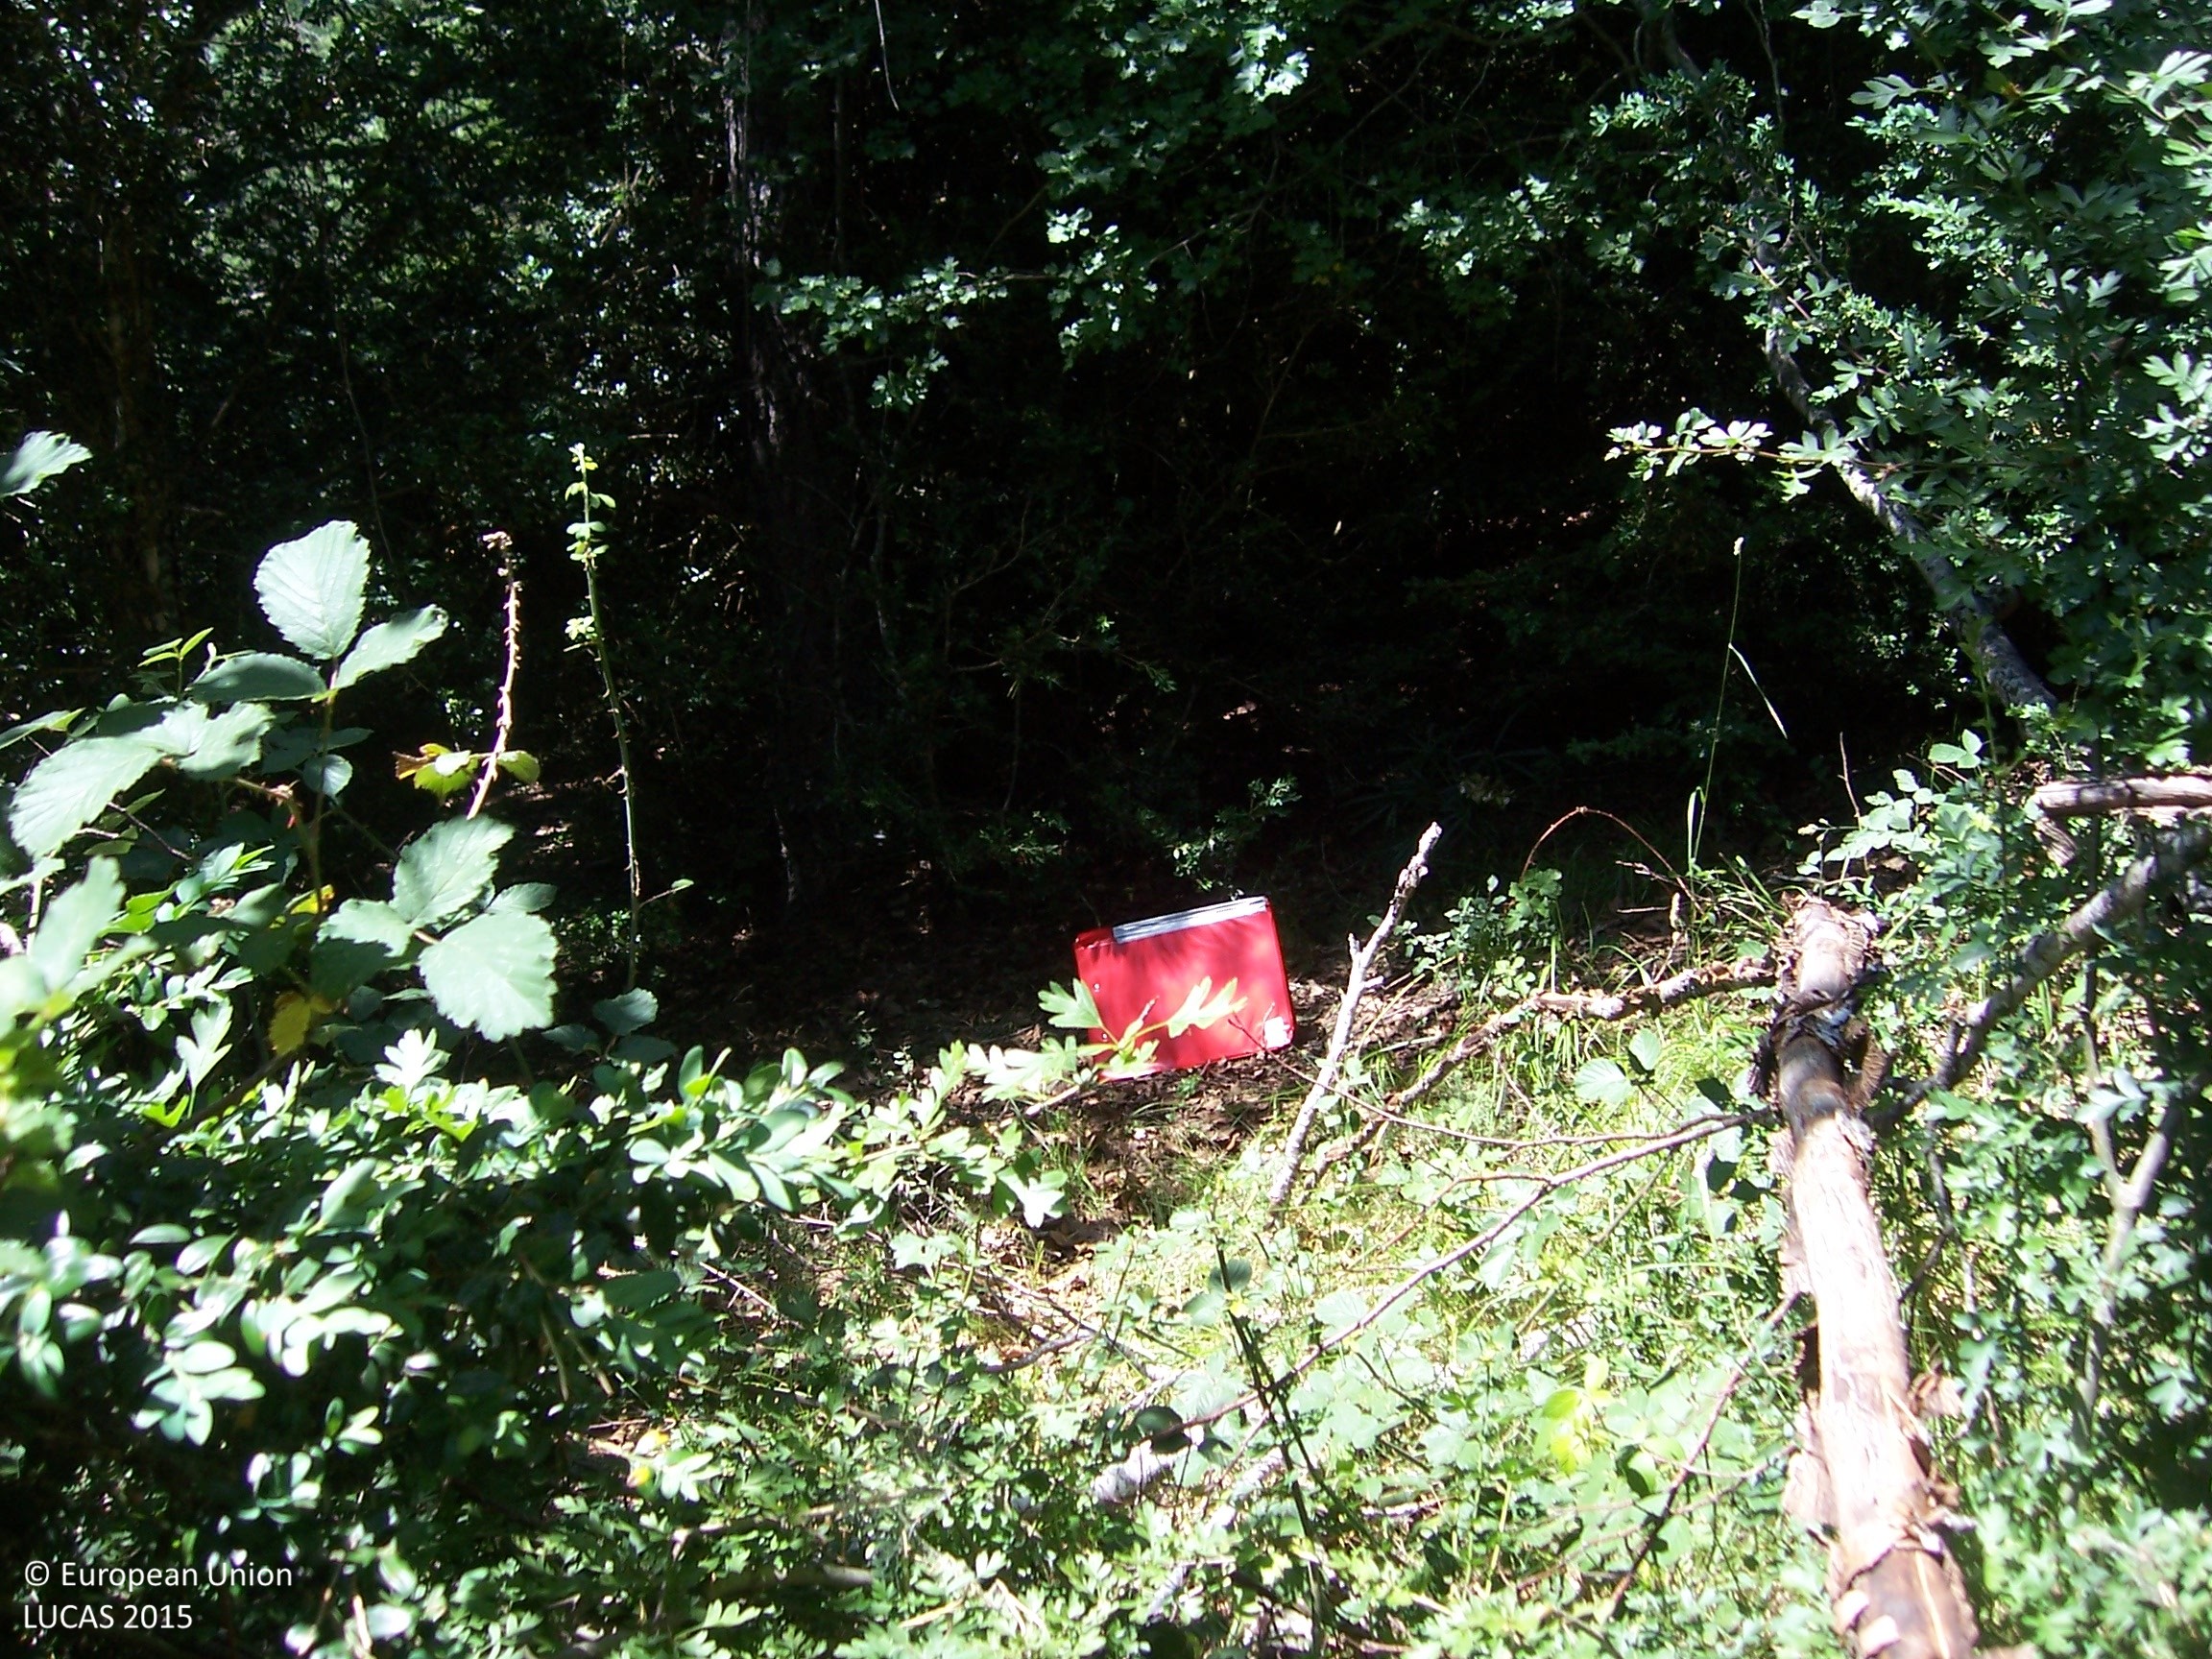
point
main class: Woodland
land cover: Broadleaved woodland
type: beech forest
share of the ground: > 75 %
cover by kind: broadleaved forest trees 75 %, coniferous forest trees 20 %, shrubs 5 %
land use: Forestry
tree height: > 5 m
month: July
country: ES
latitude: 42.8620
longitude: -1.2592
